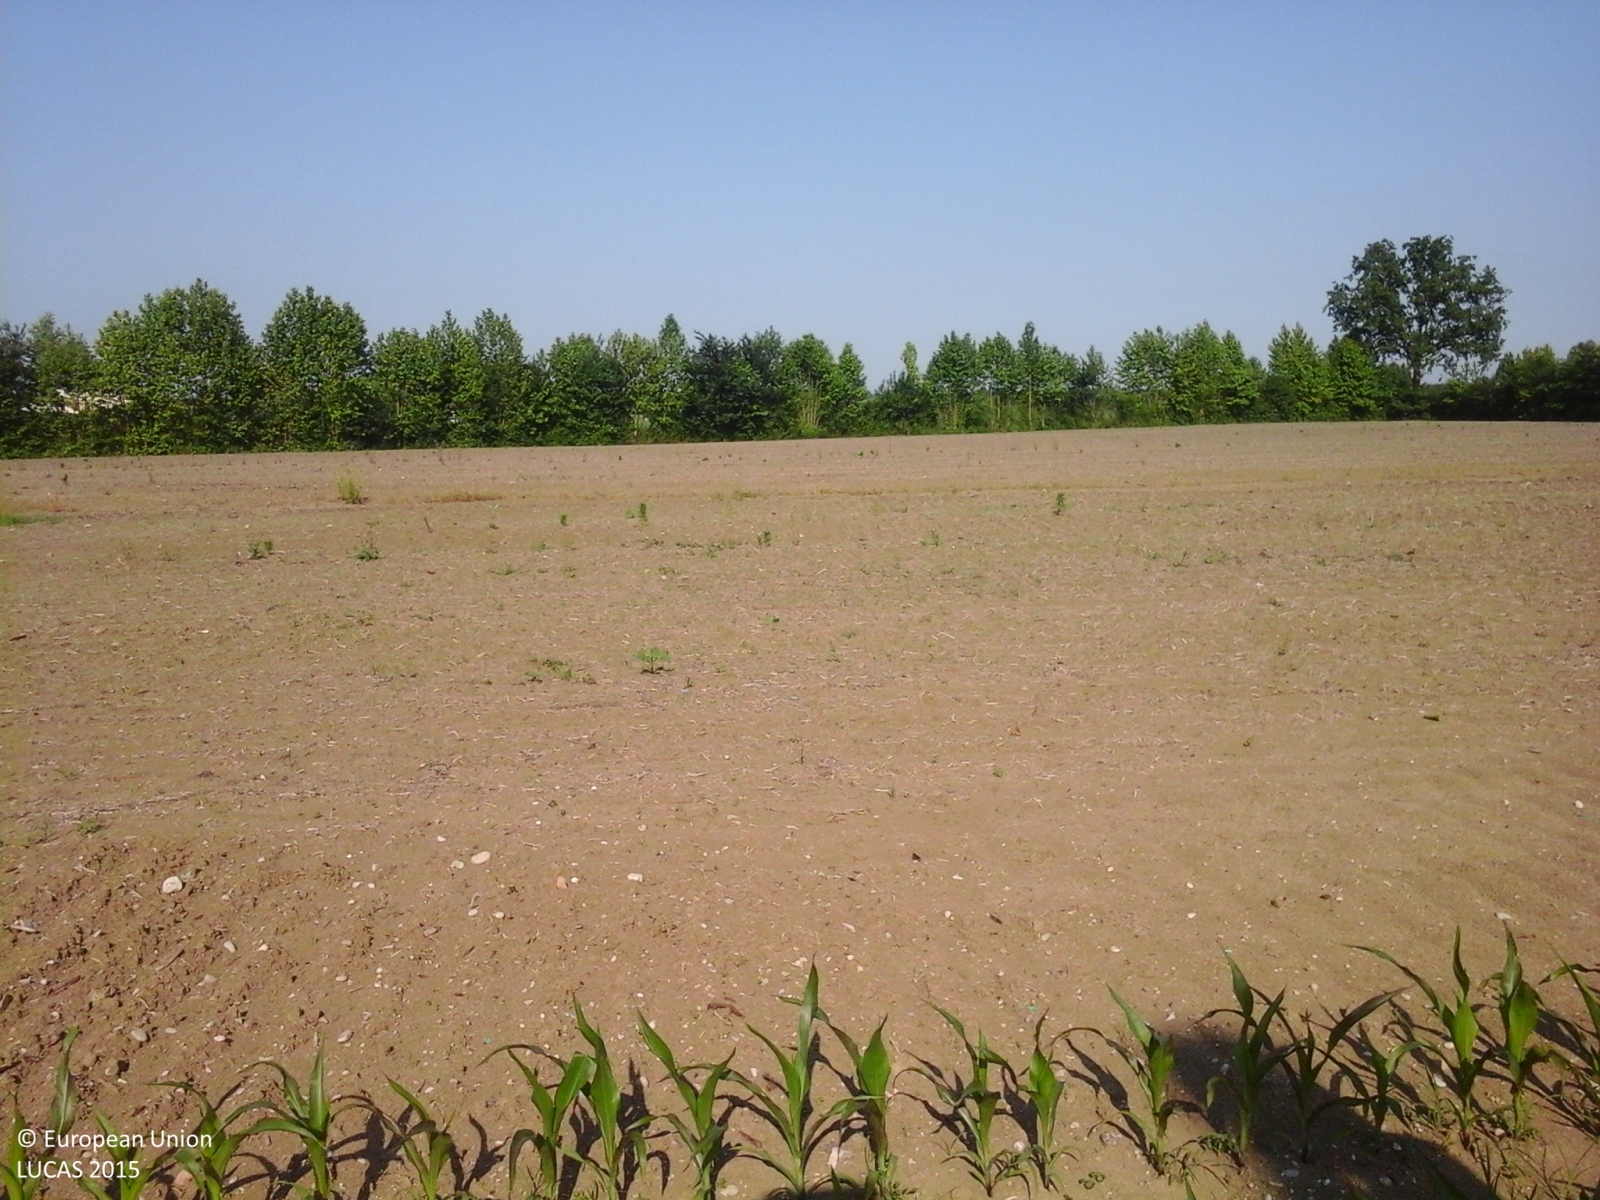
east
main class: Grassland
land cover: Grassland without tree/shrub cover
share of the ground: > 75 %
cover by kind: herbaceous plants 100 %
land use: Residential
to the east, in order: Grassland without tree/shrub cover; Managed hedges; Fences; Maize; Other bare soil; Ditches and canals; Other bare soil; Ditches and canals; Other bare soil; Ditches and canals; Other bare soil; Ditches and canals; Managed hedges; Grassland without tree/shrub cover; Soya; Ditches and canals; Soya
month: June
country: IT
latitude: 45.6407
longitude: 12.3444
